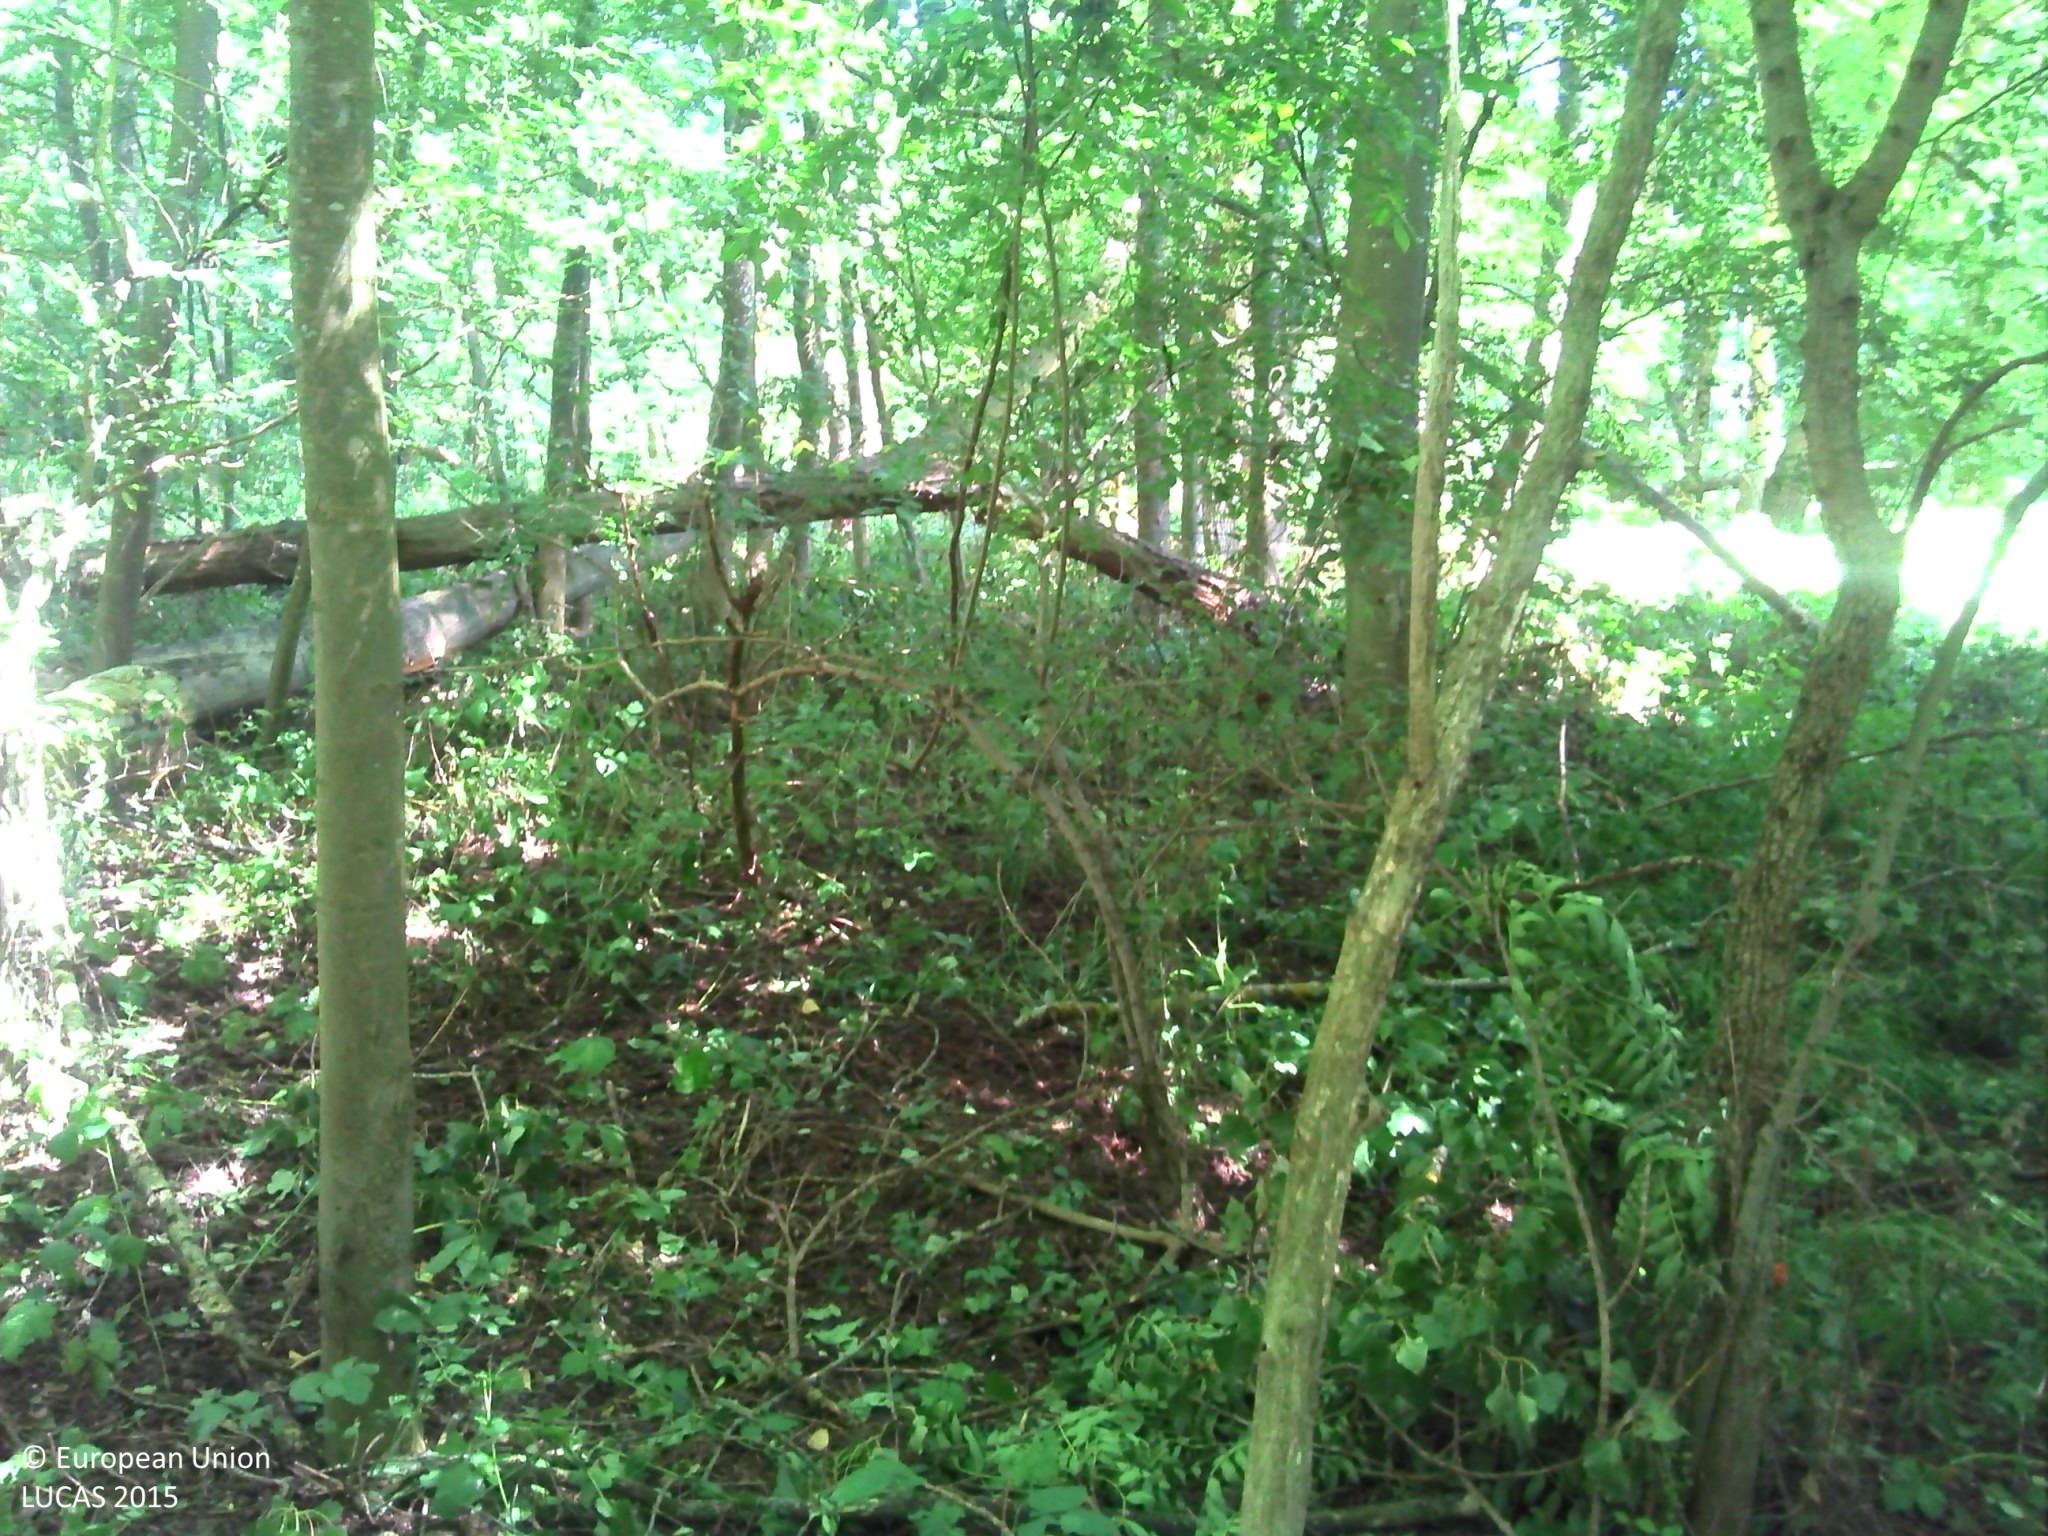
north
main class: Woodland
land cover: Broadleaved woodland
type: floodplain forest
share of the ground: > 75 %
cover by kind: broadleaved forest trees 100 %
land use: Forestry
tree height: > 5 m
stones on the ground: < 10 %
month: July
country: FR
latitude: 45.3506
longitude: 3.3775
